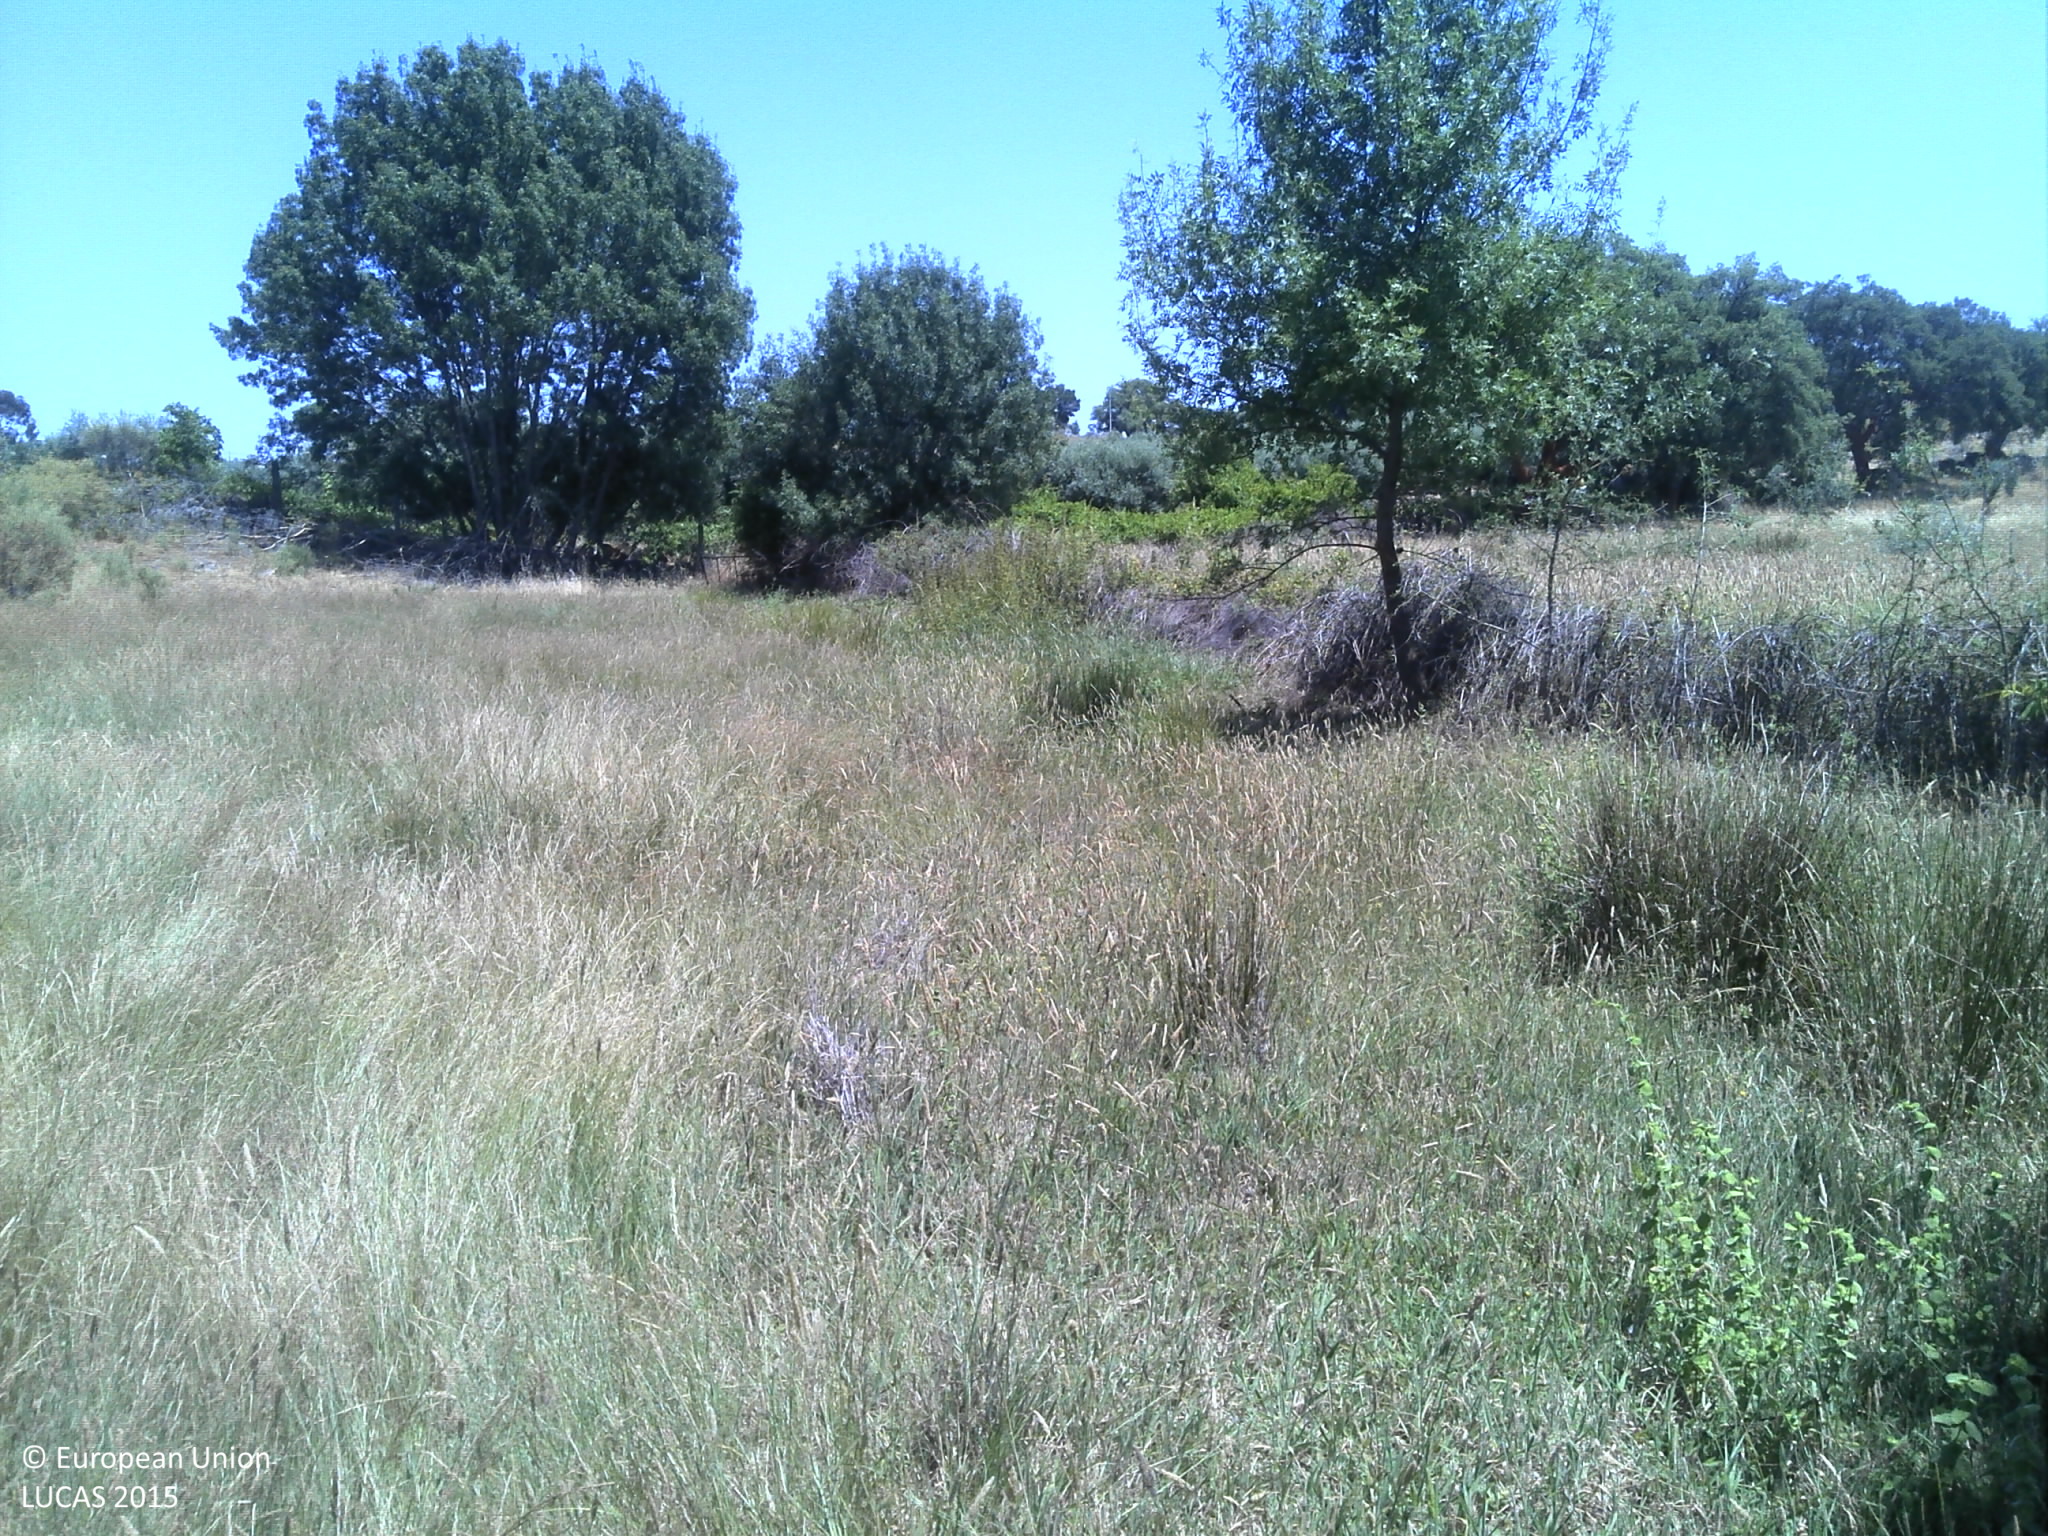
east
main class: Grassland
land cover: Grassland without tree/shrub cover
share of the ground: 50 - 75 %
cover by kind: herbaceous plants 60 %, unconsolidated bare surface 30 %, shrubs 5 %
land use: Agriculture (excluding fallow land and kitchen gardens)
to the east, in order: Grassland without tree/shrub cover; Abandoned hedges; Fences; Dry stone walls; Ditches and canals; Dry stone walls; Olive groves; Dry stone walls; Inland fresh water bodies; Olive groves; Dry stone walls; Tracks; Vineyards; Rocks and stones; Shrubland without tree cover
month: June
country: PT
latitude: 39.8816
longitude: -7.3917
